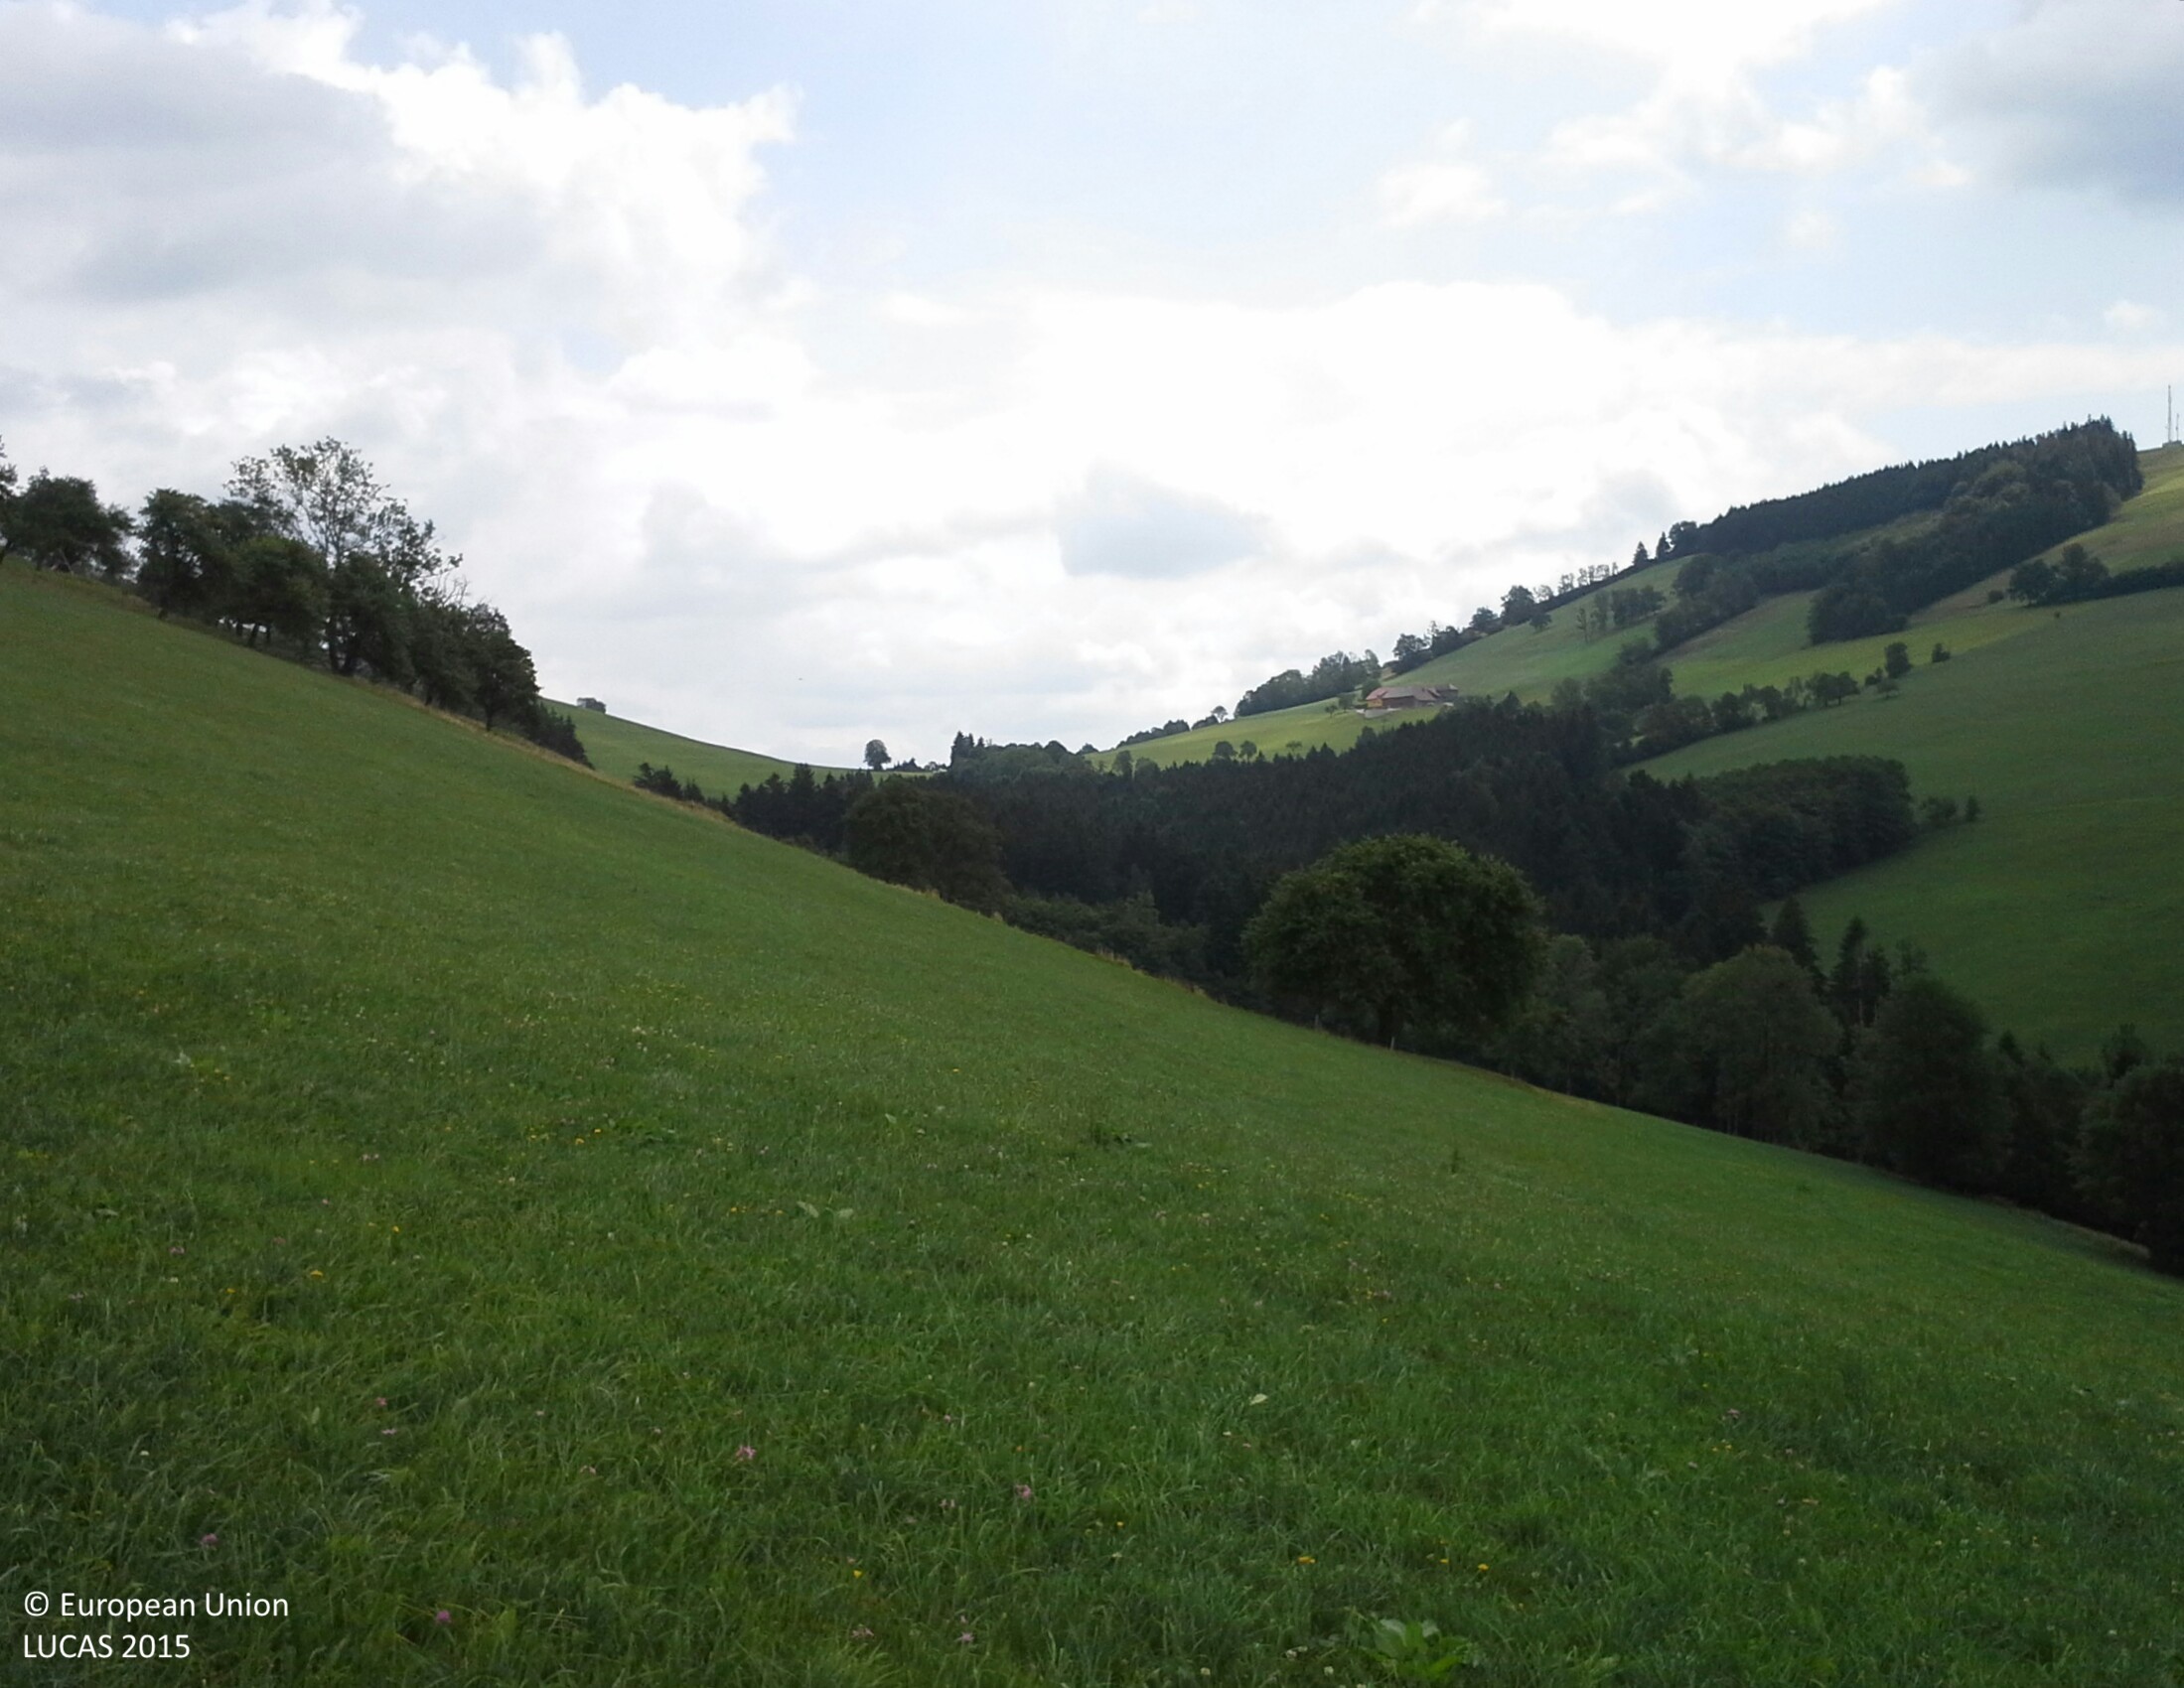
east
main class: Grassland
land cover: Grassland without tree/shrub cover
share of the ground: > 75 %
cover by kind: herbaceous plants 100 %
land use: Agriculture (excluding fallow land and kitchen gardens)
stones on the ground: > 50 %
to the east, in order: Grassland without tree/shrub cover; Fences; Grassland without tree/shrub cover; Fences; Grassland without tree/shrub cover
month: July
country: AT
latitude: 47.9656
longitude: 14.5941
